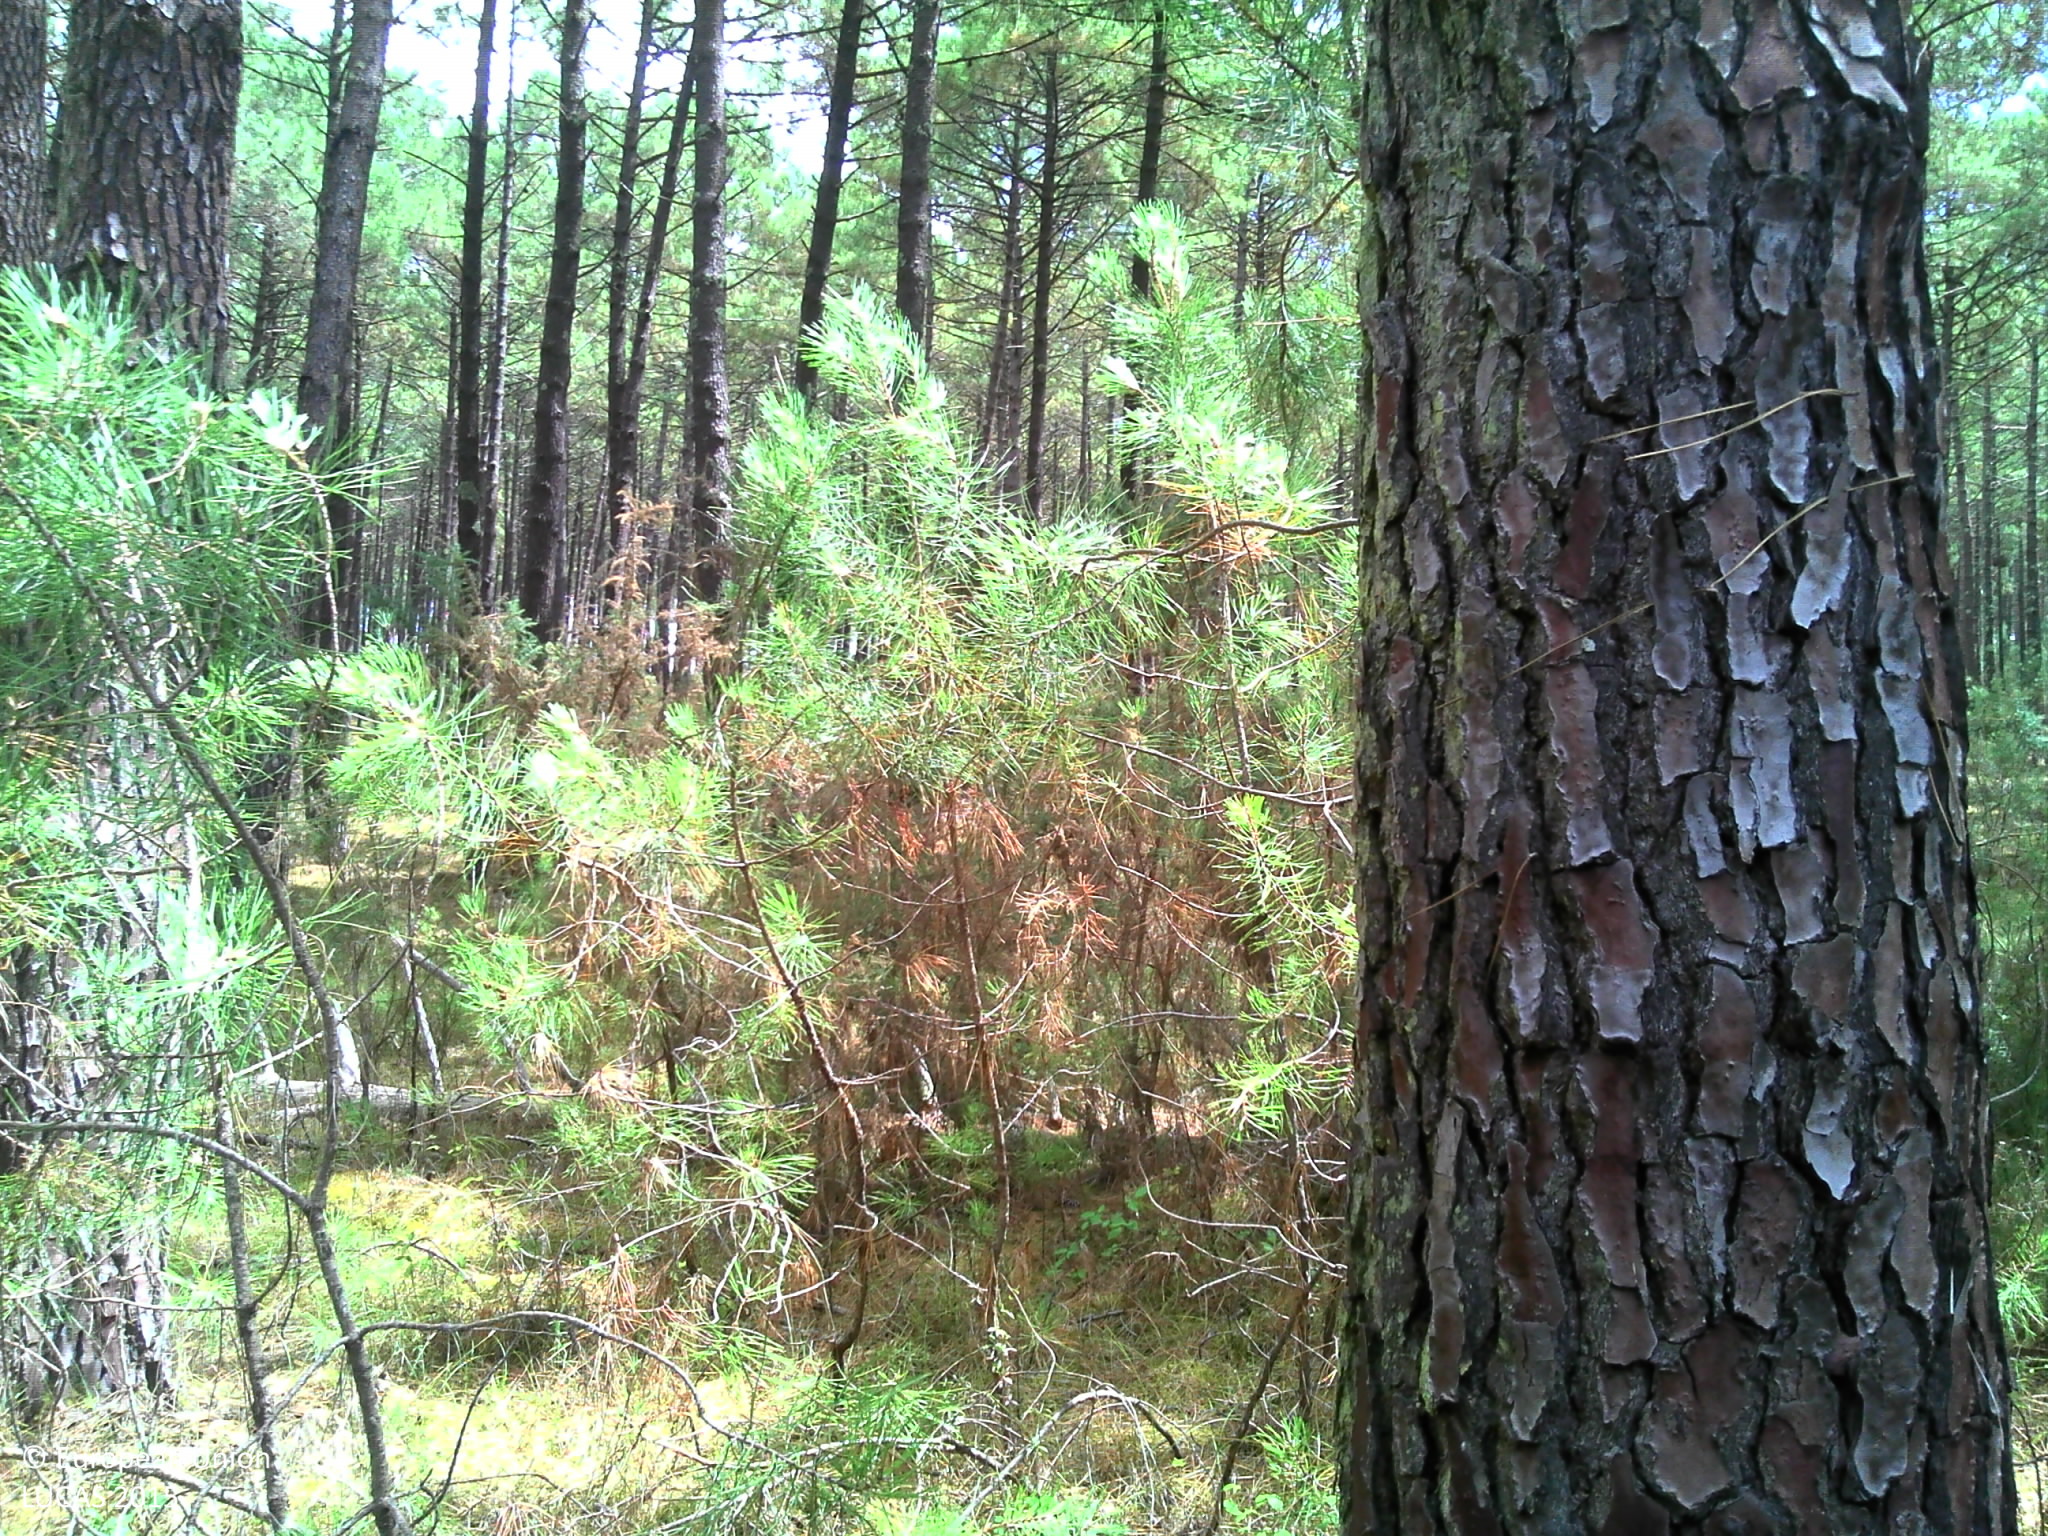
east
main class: Woodland
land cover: Pine dominated coniferous woodland
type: coniferous forest of the mediterranean region
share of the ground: > 75 %
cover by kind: coniferous forest trees 80 %, herbaceous plants 10 %, lichens and mosses 10 %
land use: Forestry
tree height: > 5 m
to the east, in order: Pine dominated coniferous woodland; Tracks
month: July
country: FR
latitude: 44.1691
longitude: -1.2896
